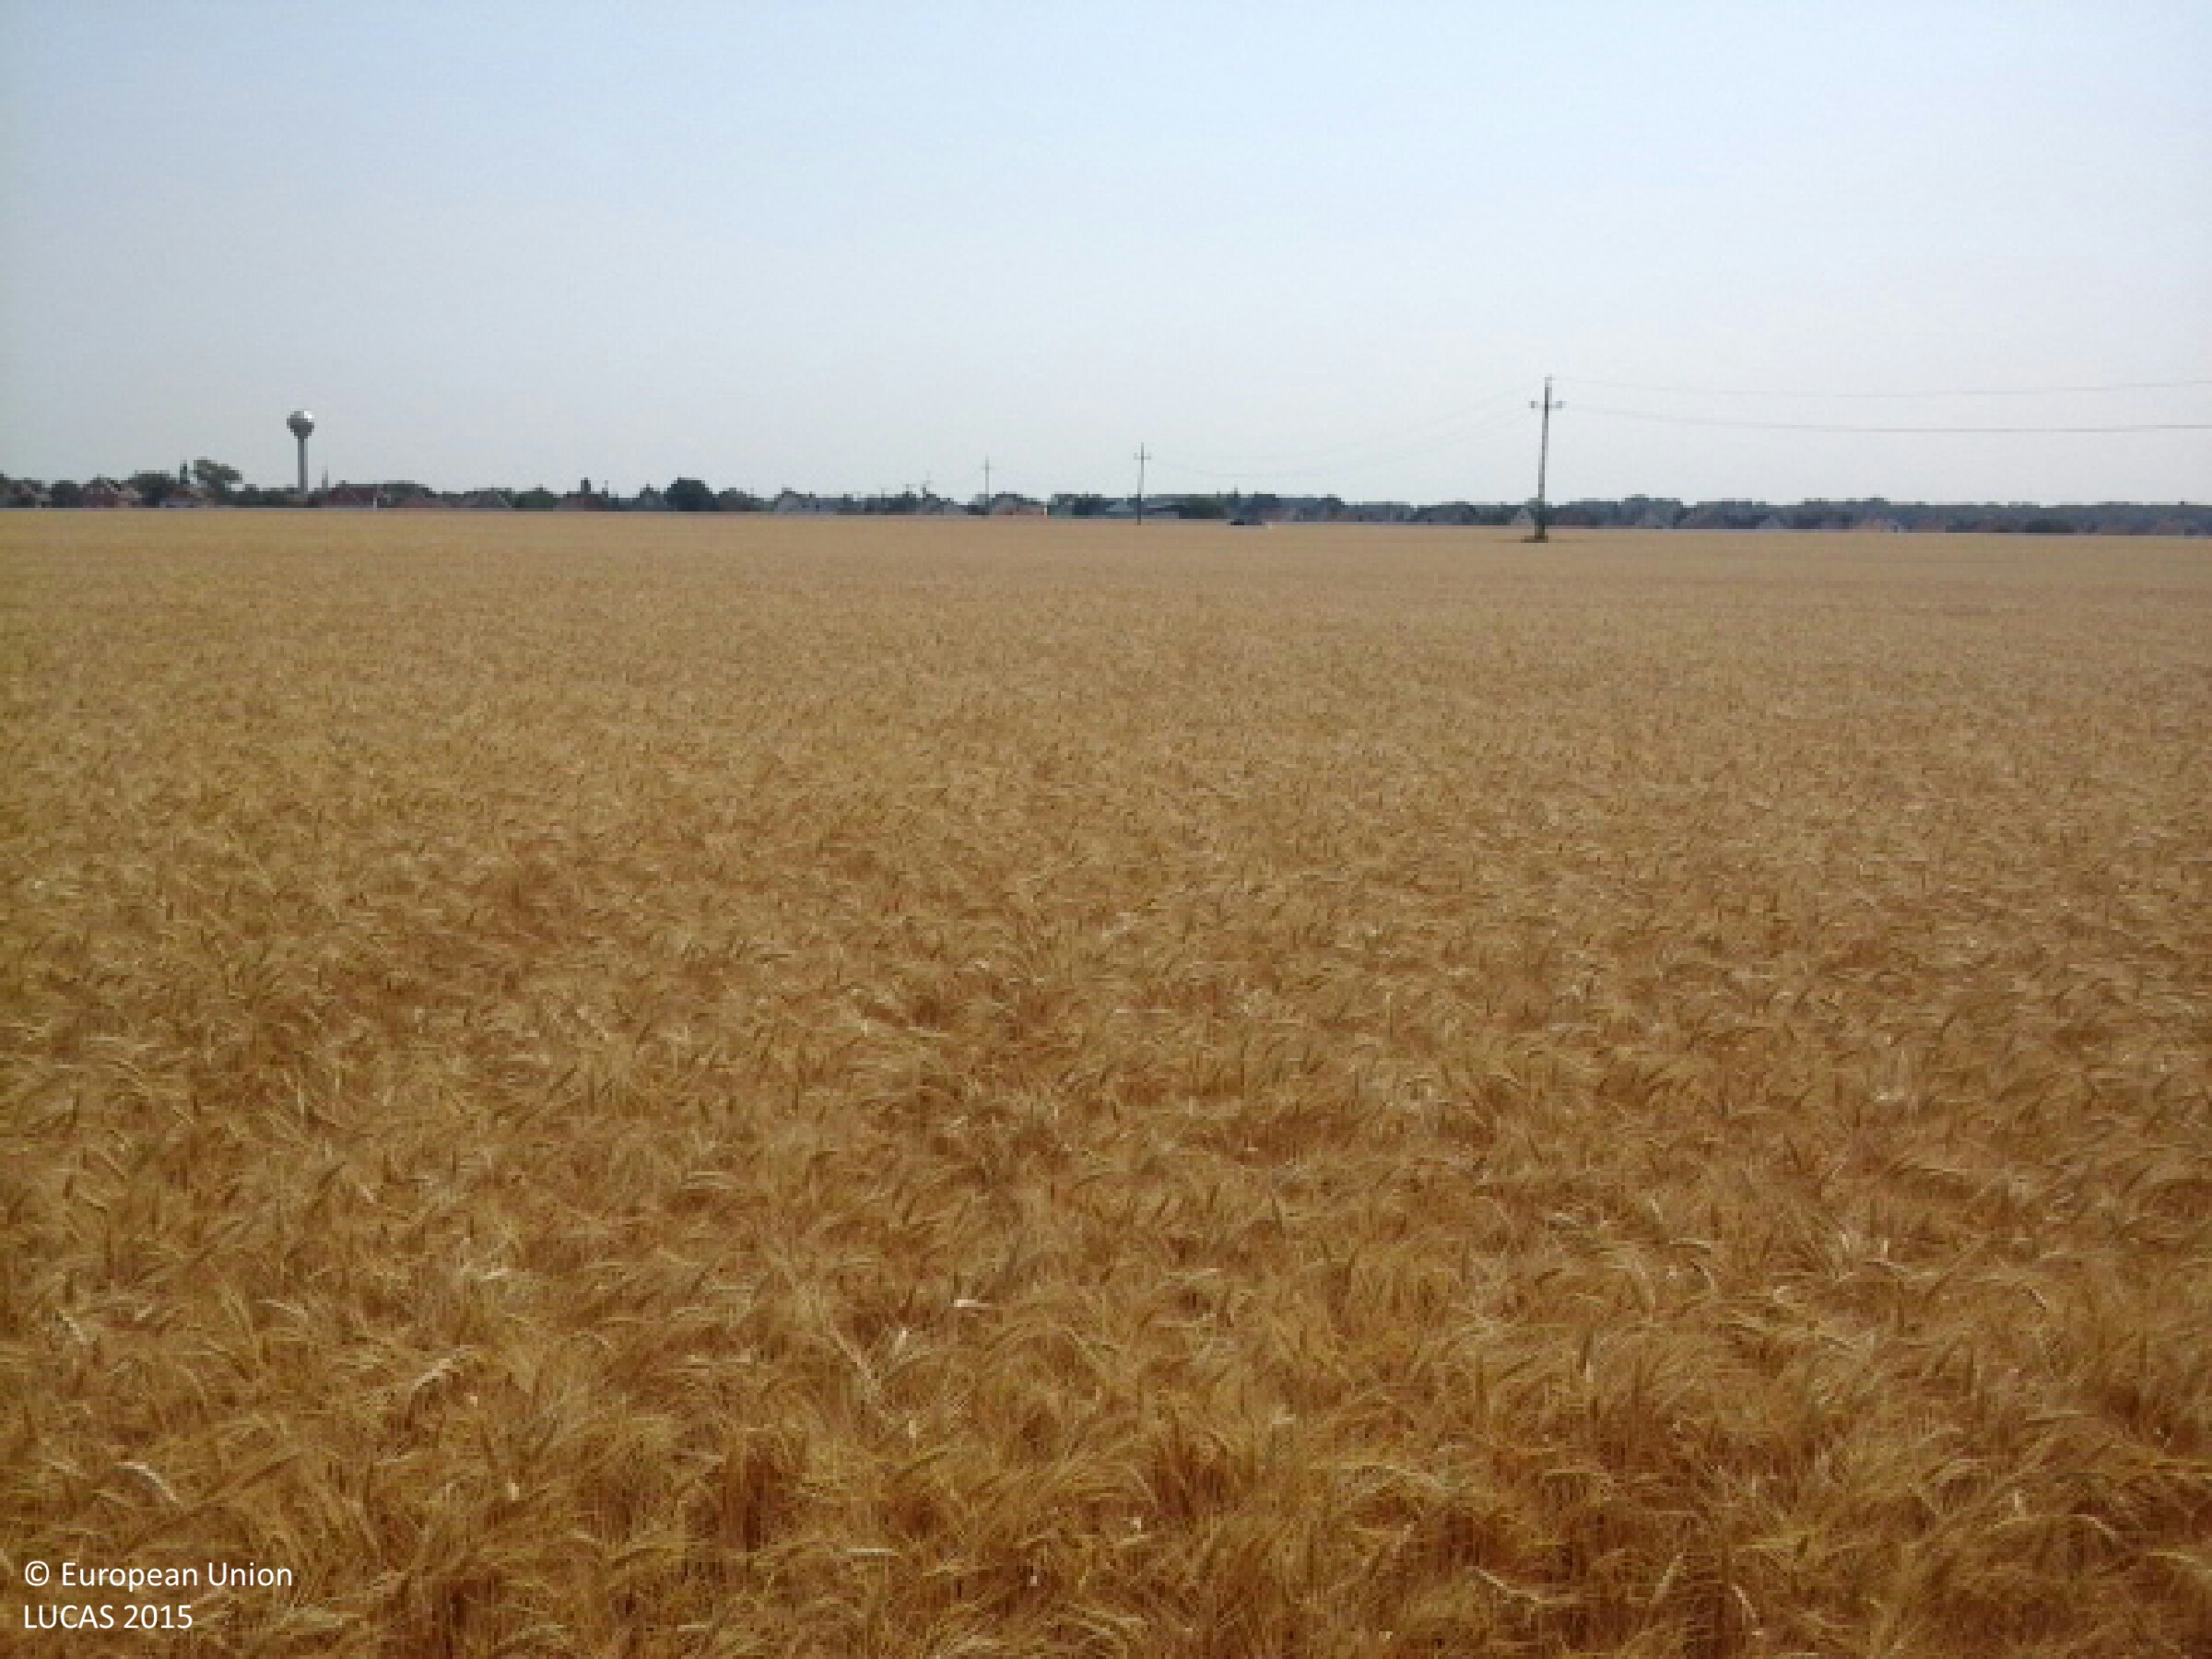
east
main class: Cropland
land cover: Triticale
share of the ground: > 75 %
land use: Agriculture (excluding fallow land and kitchen gardens)
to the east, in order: Triticale; Electric lines; Triticale
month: July
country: HU
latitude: 48.0295
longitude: 21.0493
